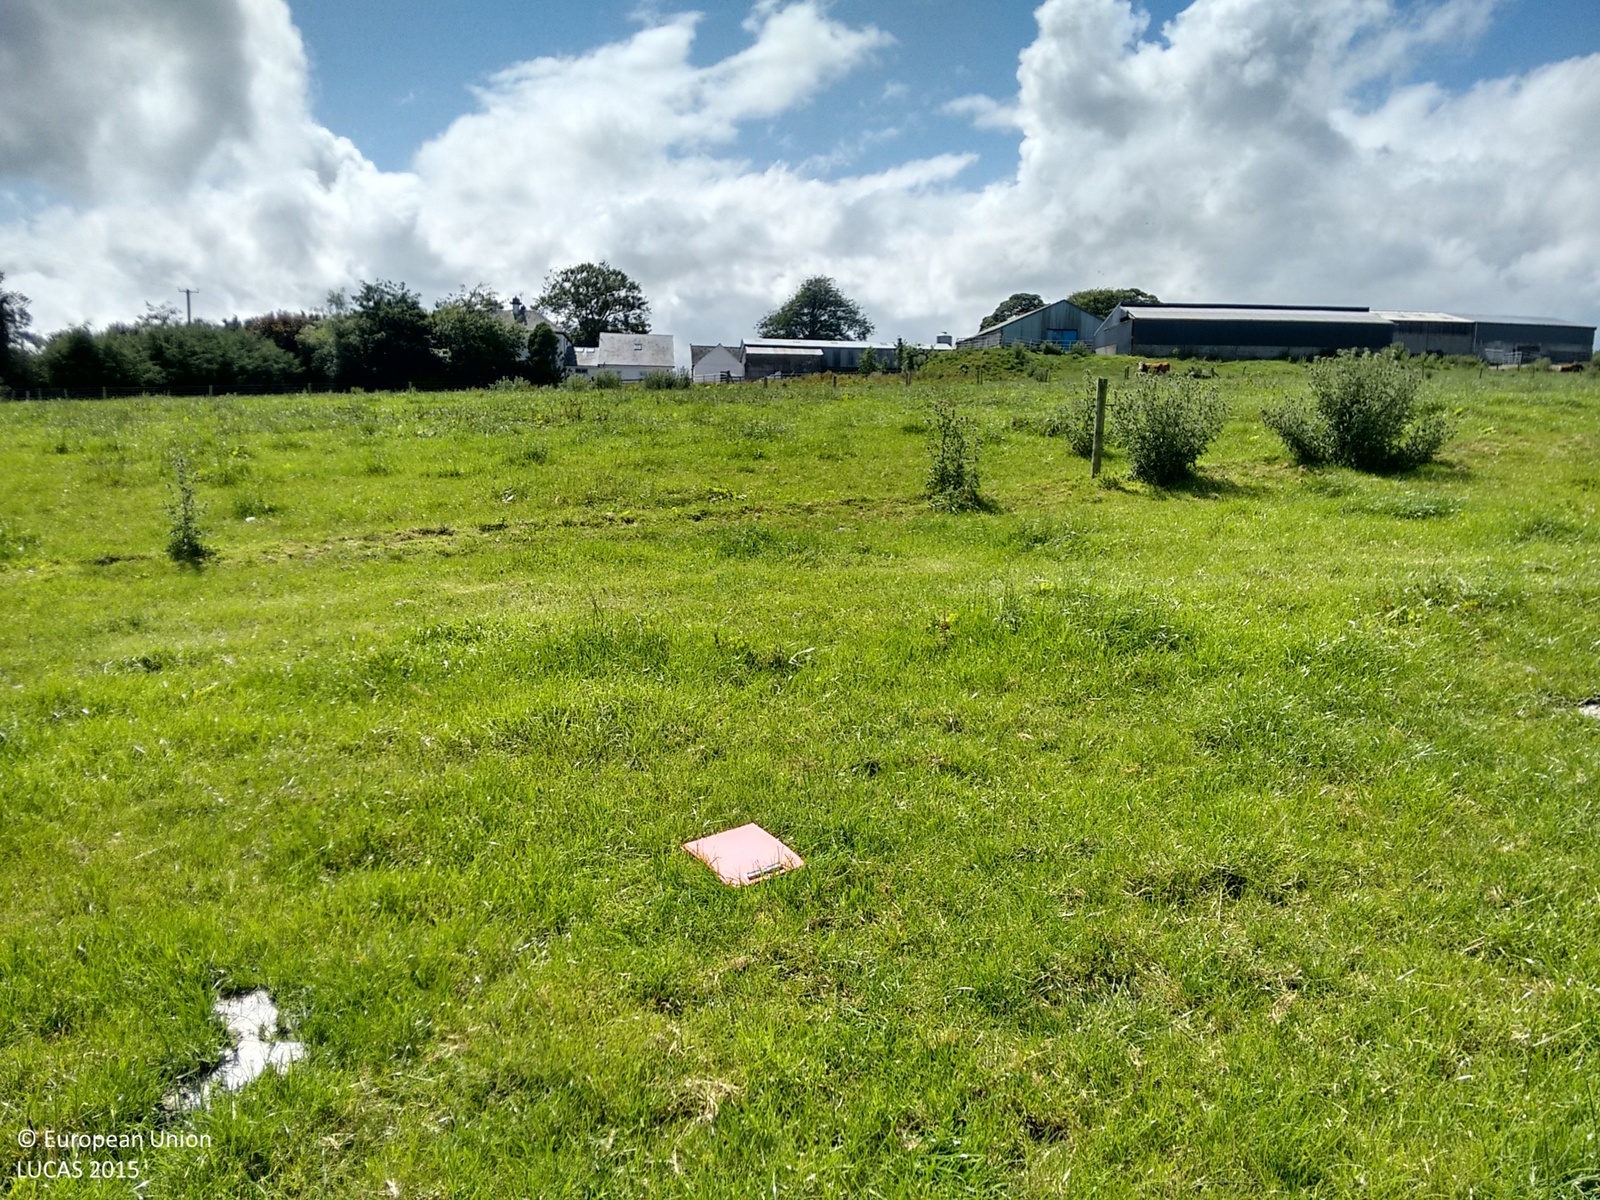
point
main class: Grassland
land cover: Grassland without tree/shrub cover
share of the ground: > 75 %
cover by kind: herbaceous plants 100 %
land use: Agriculture (excluding fallow land and kitchen gardens)
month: July
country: IE
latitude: 52.6951
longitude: -7.4238
